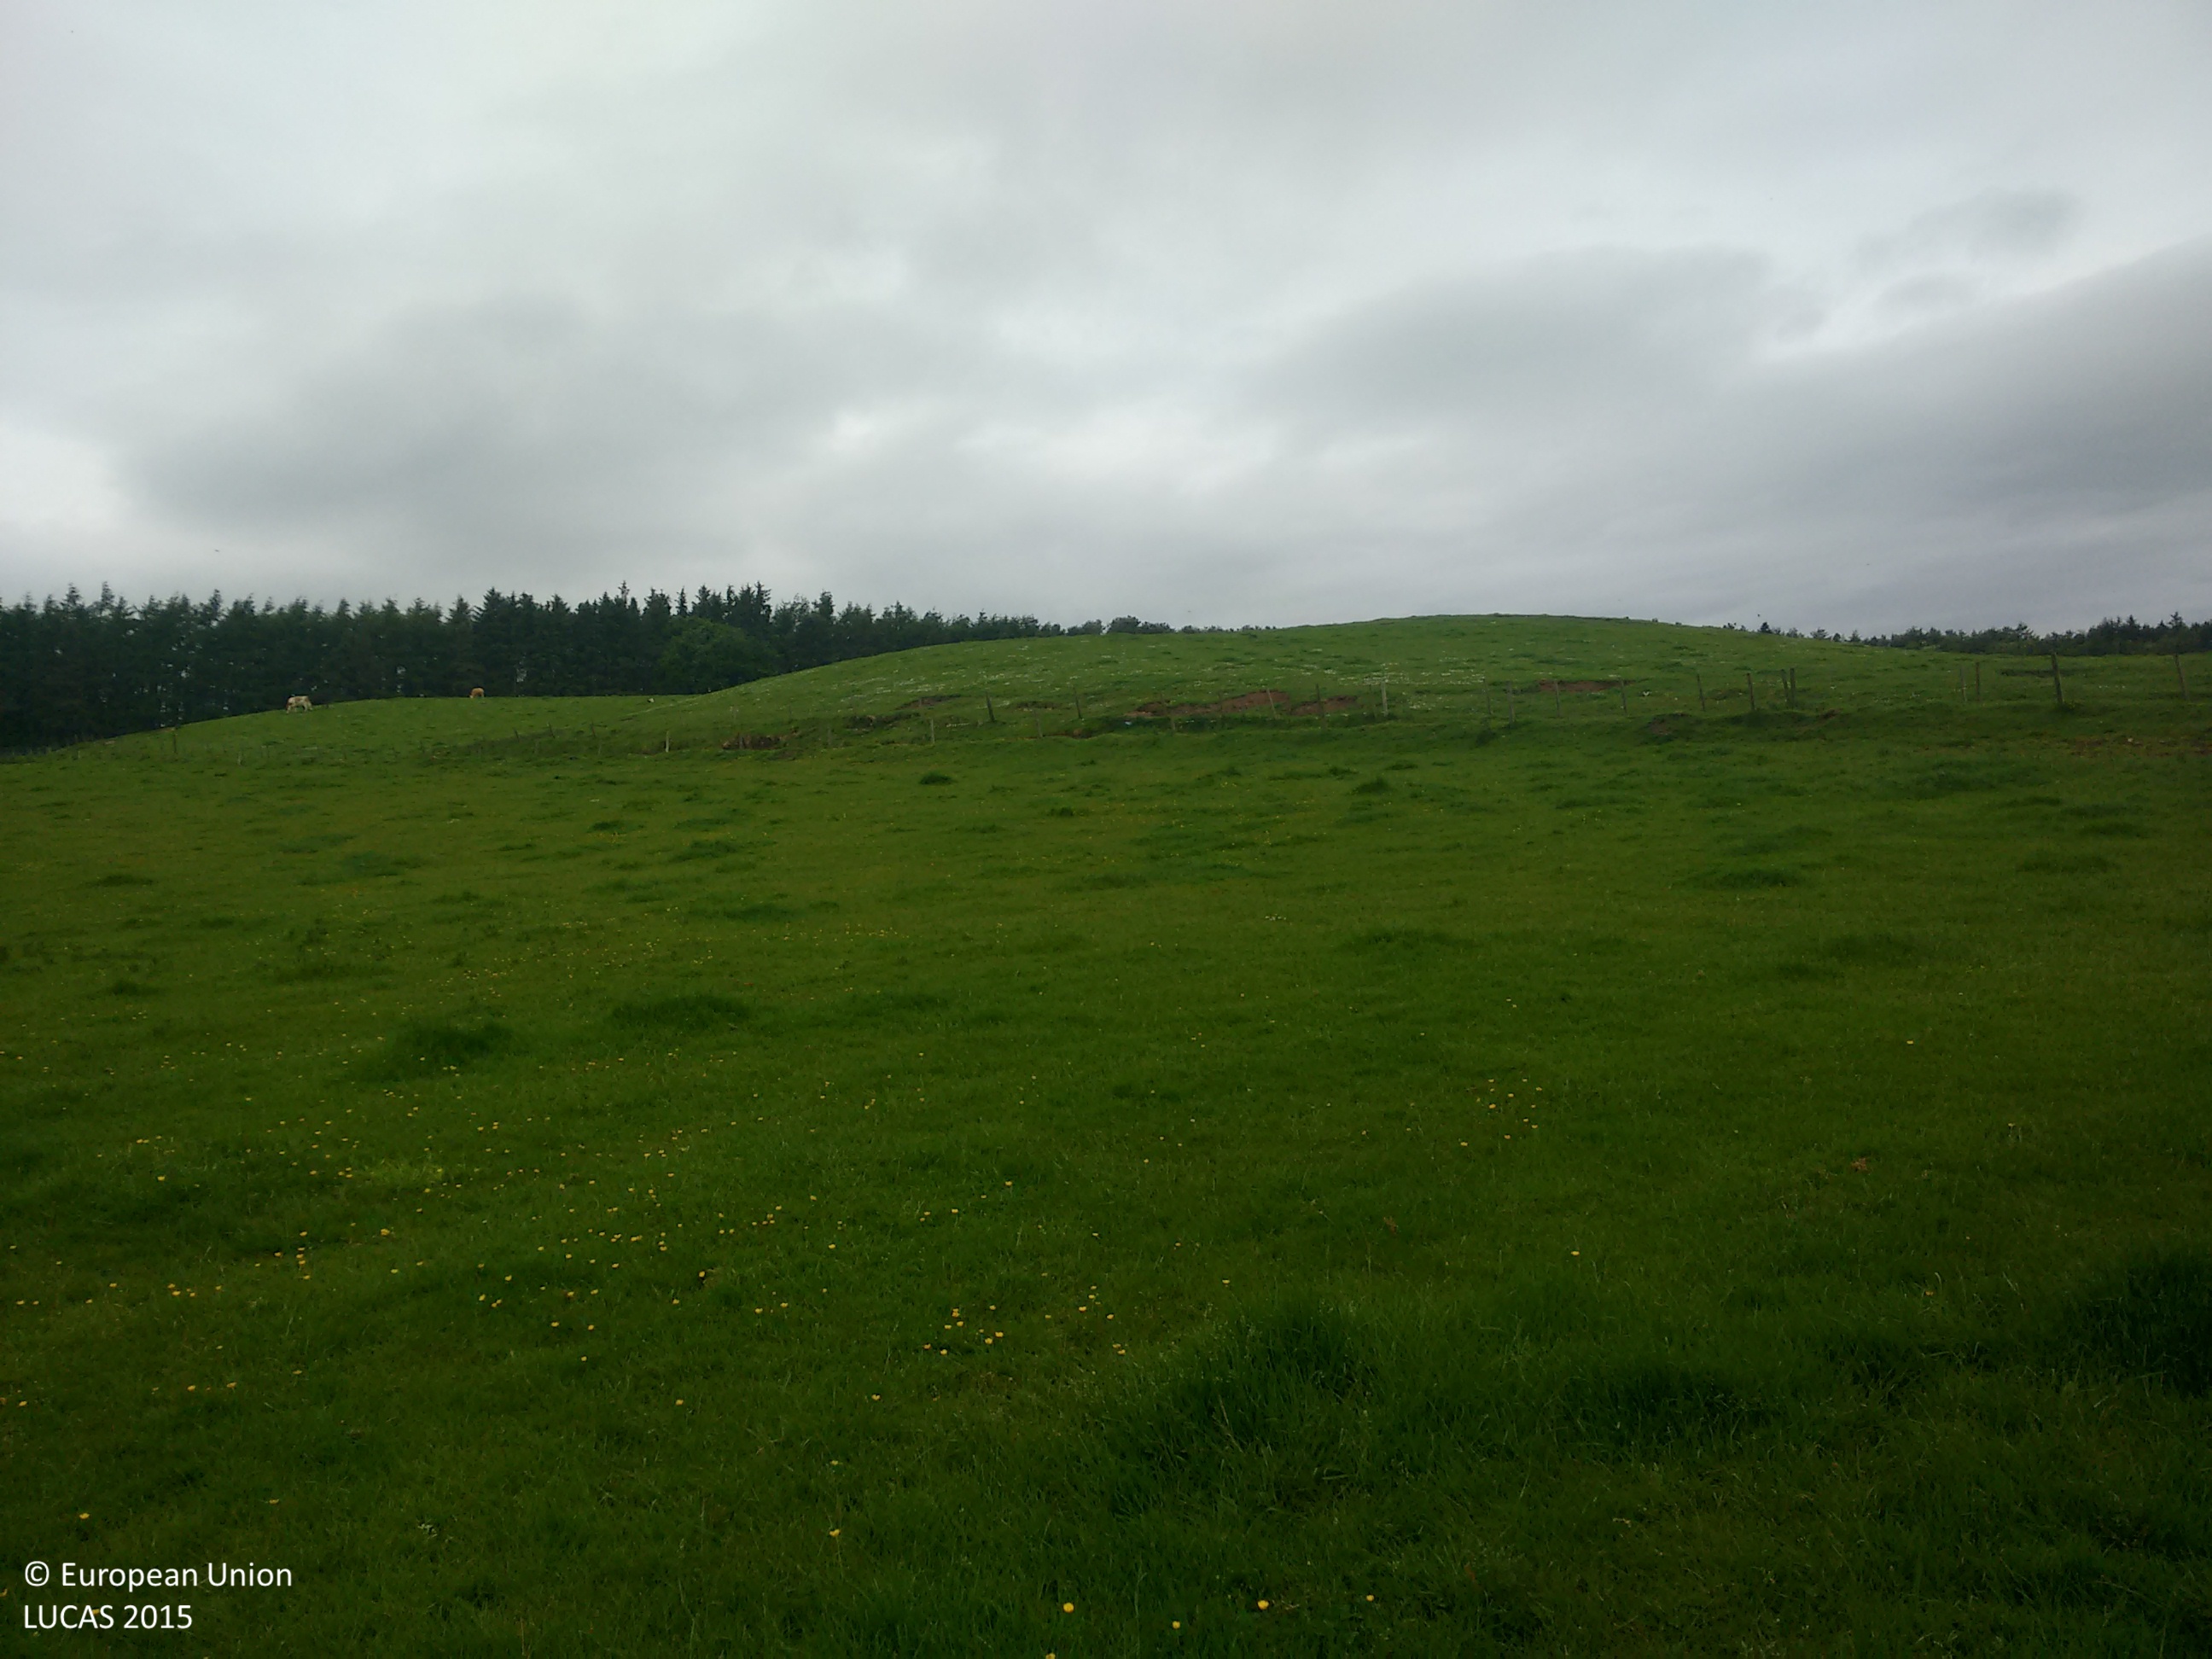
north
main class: Grassland
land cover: Grassland without tree/shrub cover
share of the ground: > 75 %
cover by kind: herbaceous plants 100 %
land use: Agriculture (excluding fallow land and kitchen gardens)
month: June
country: GB
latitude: 55.6978
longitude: -3.5882
